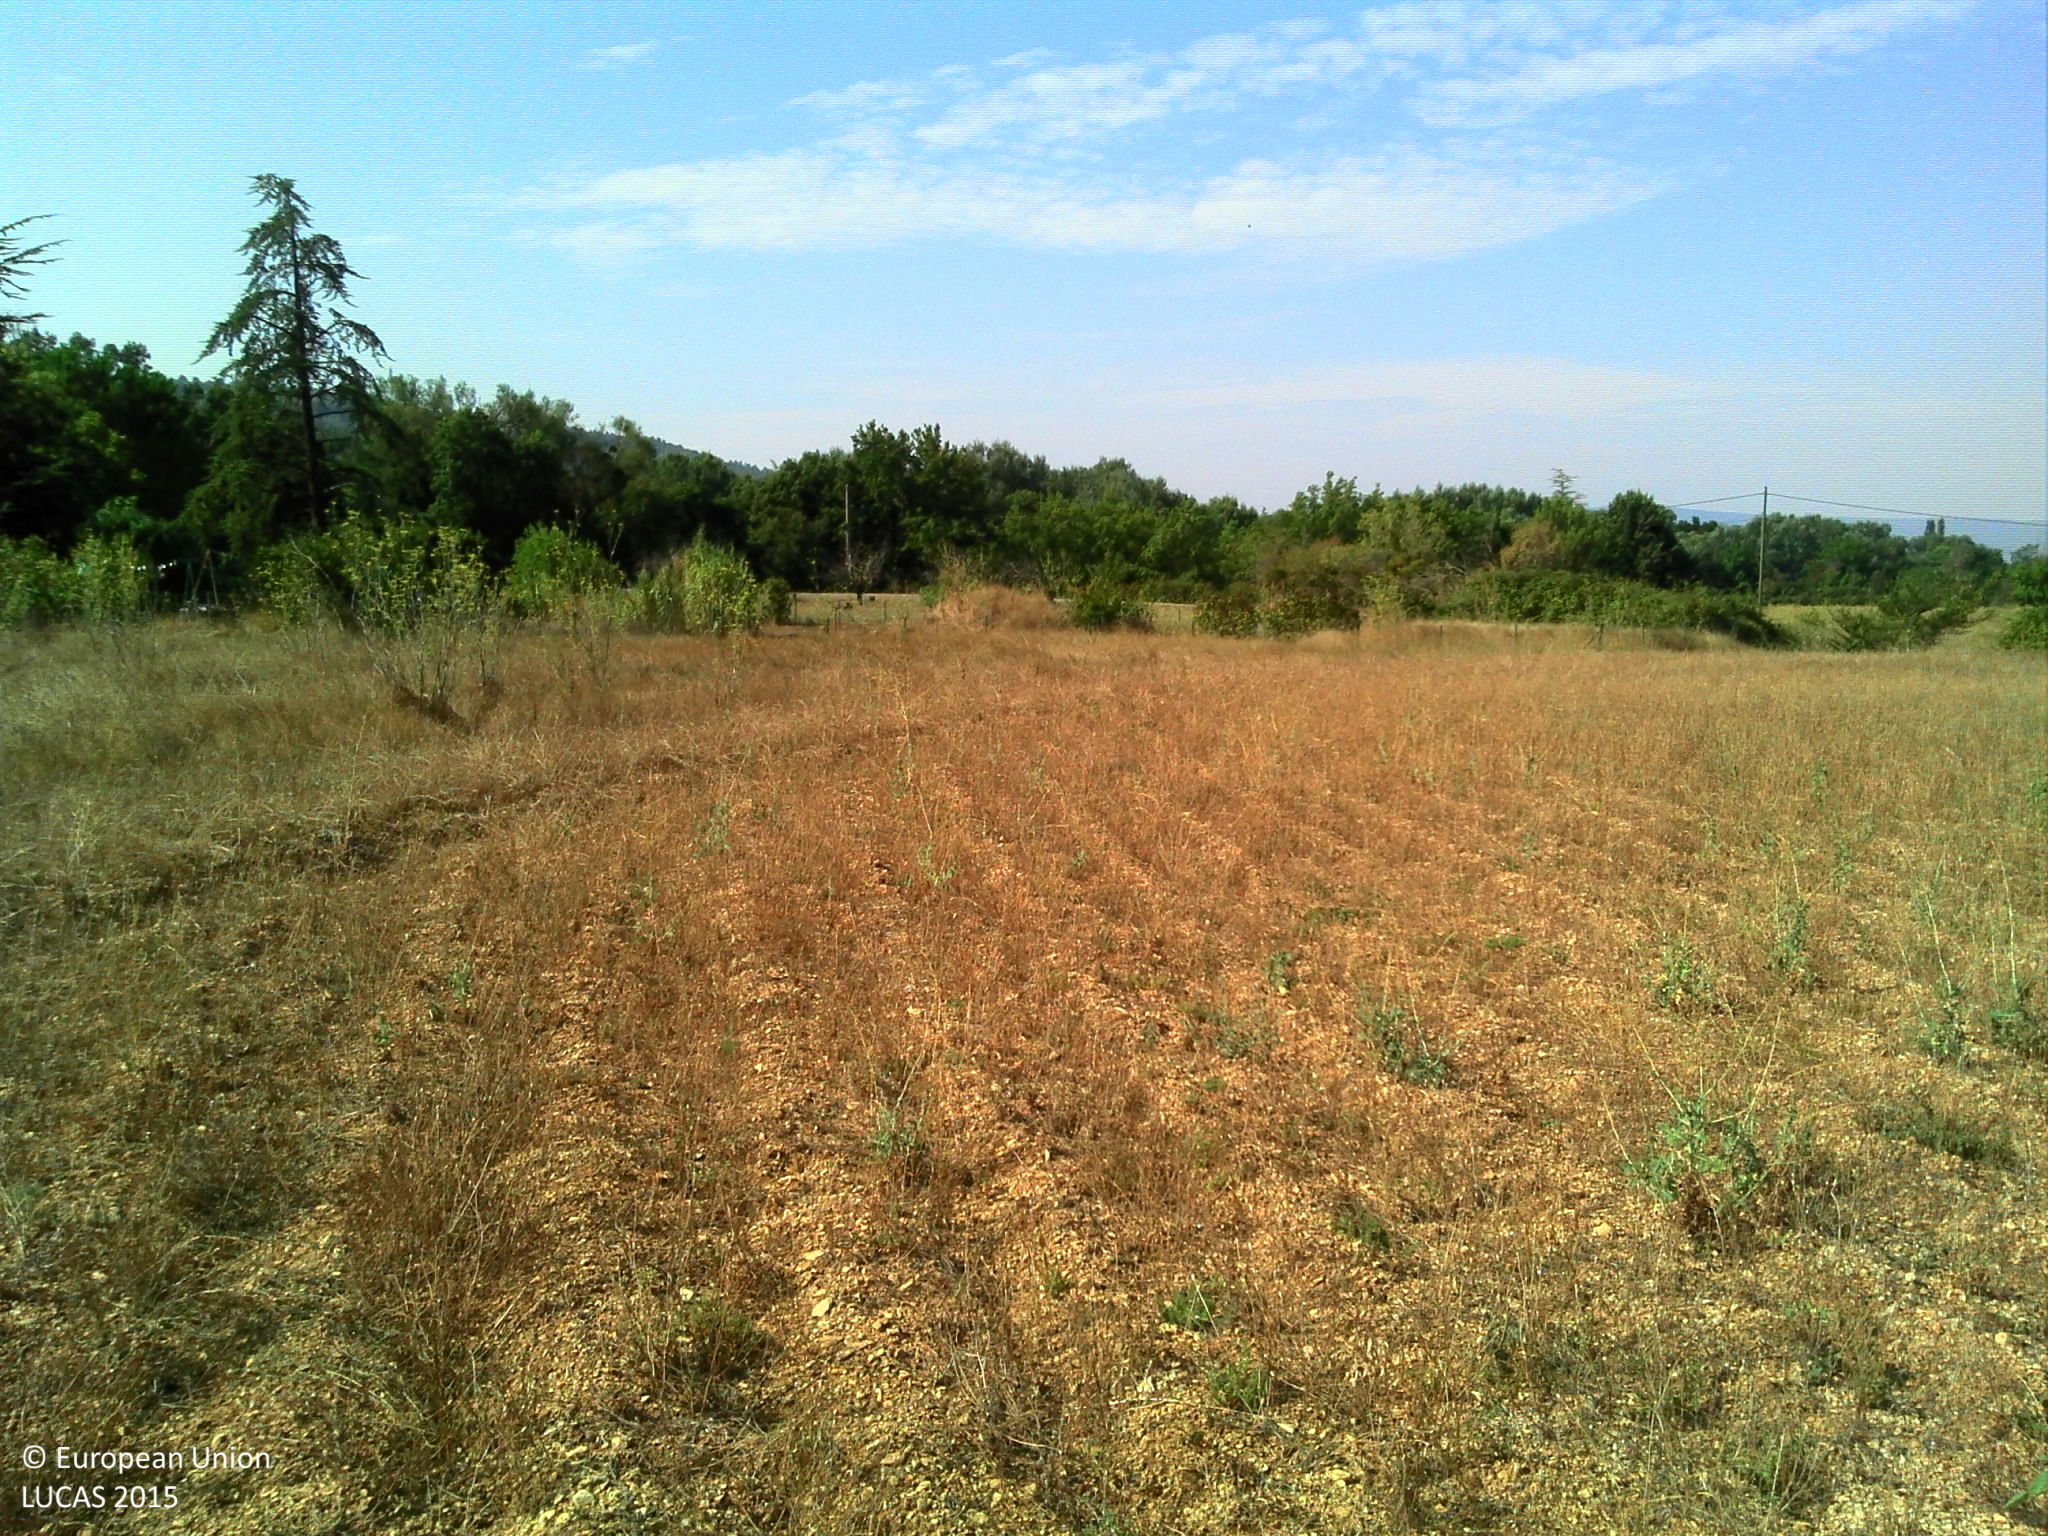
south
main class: Grassland
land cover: Spontaneously vegetated surfaces
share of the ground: > 75 %
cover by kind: herbaceous plants 70 %, unconsolidated bare surface 30 %
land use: Semi-natural and natural areas not in use
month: August
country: FR
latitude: 43.9240
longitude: 5.4127
